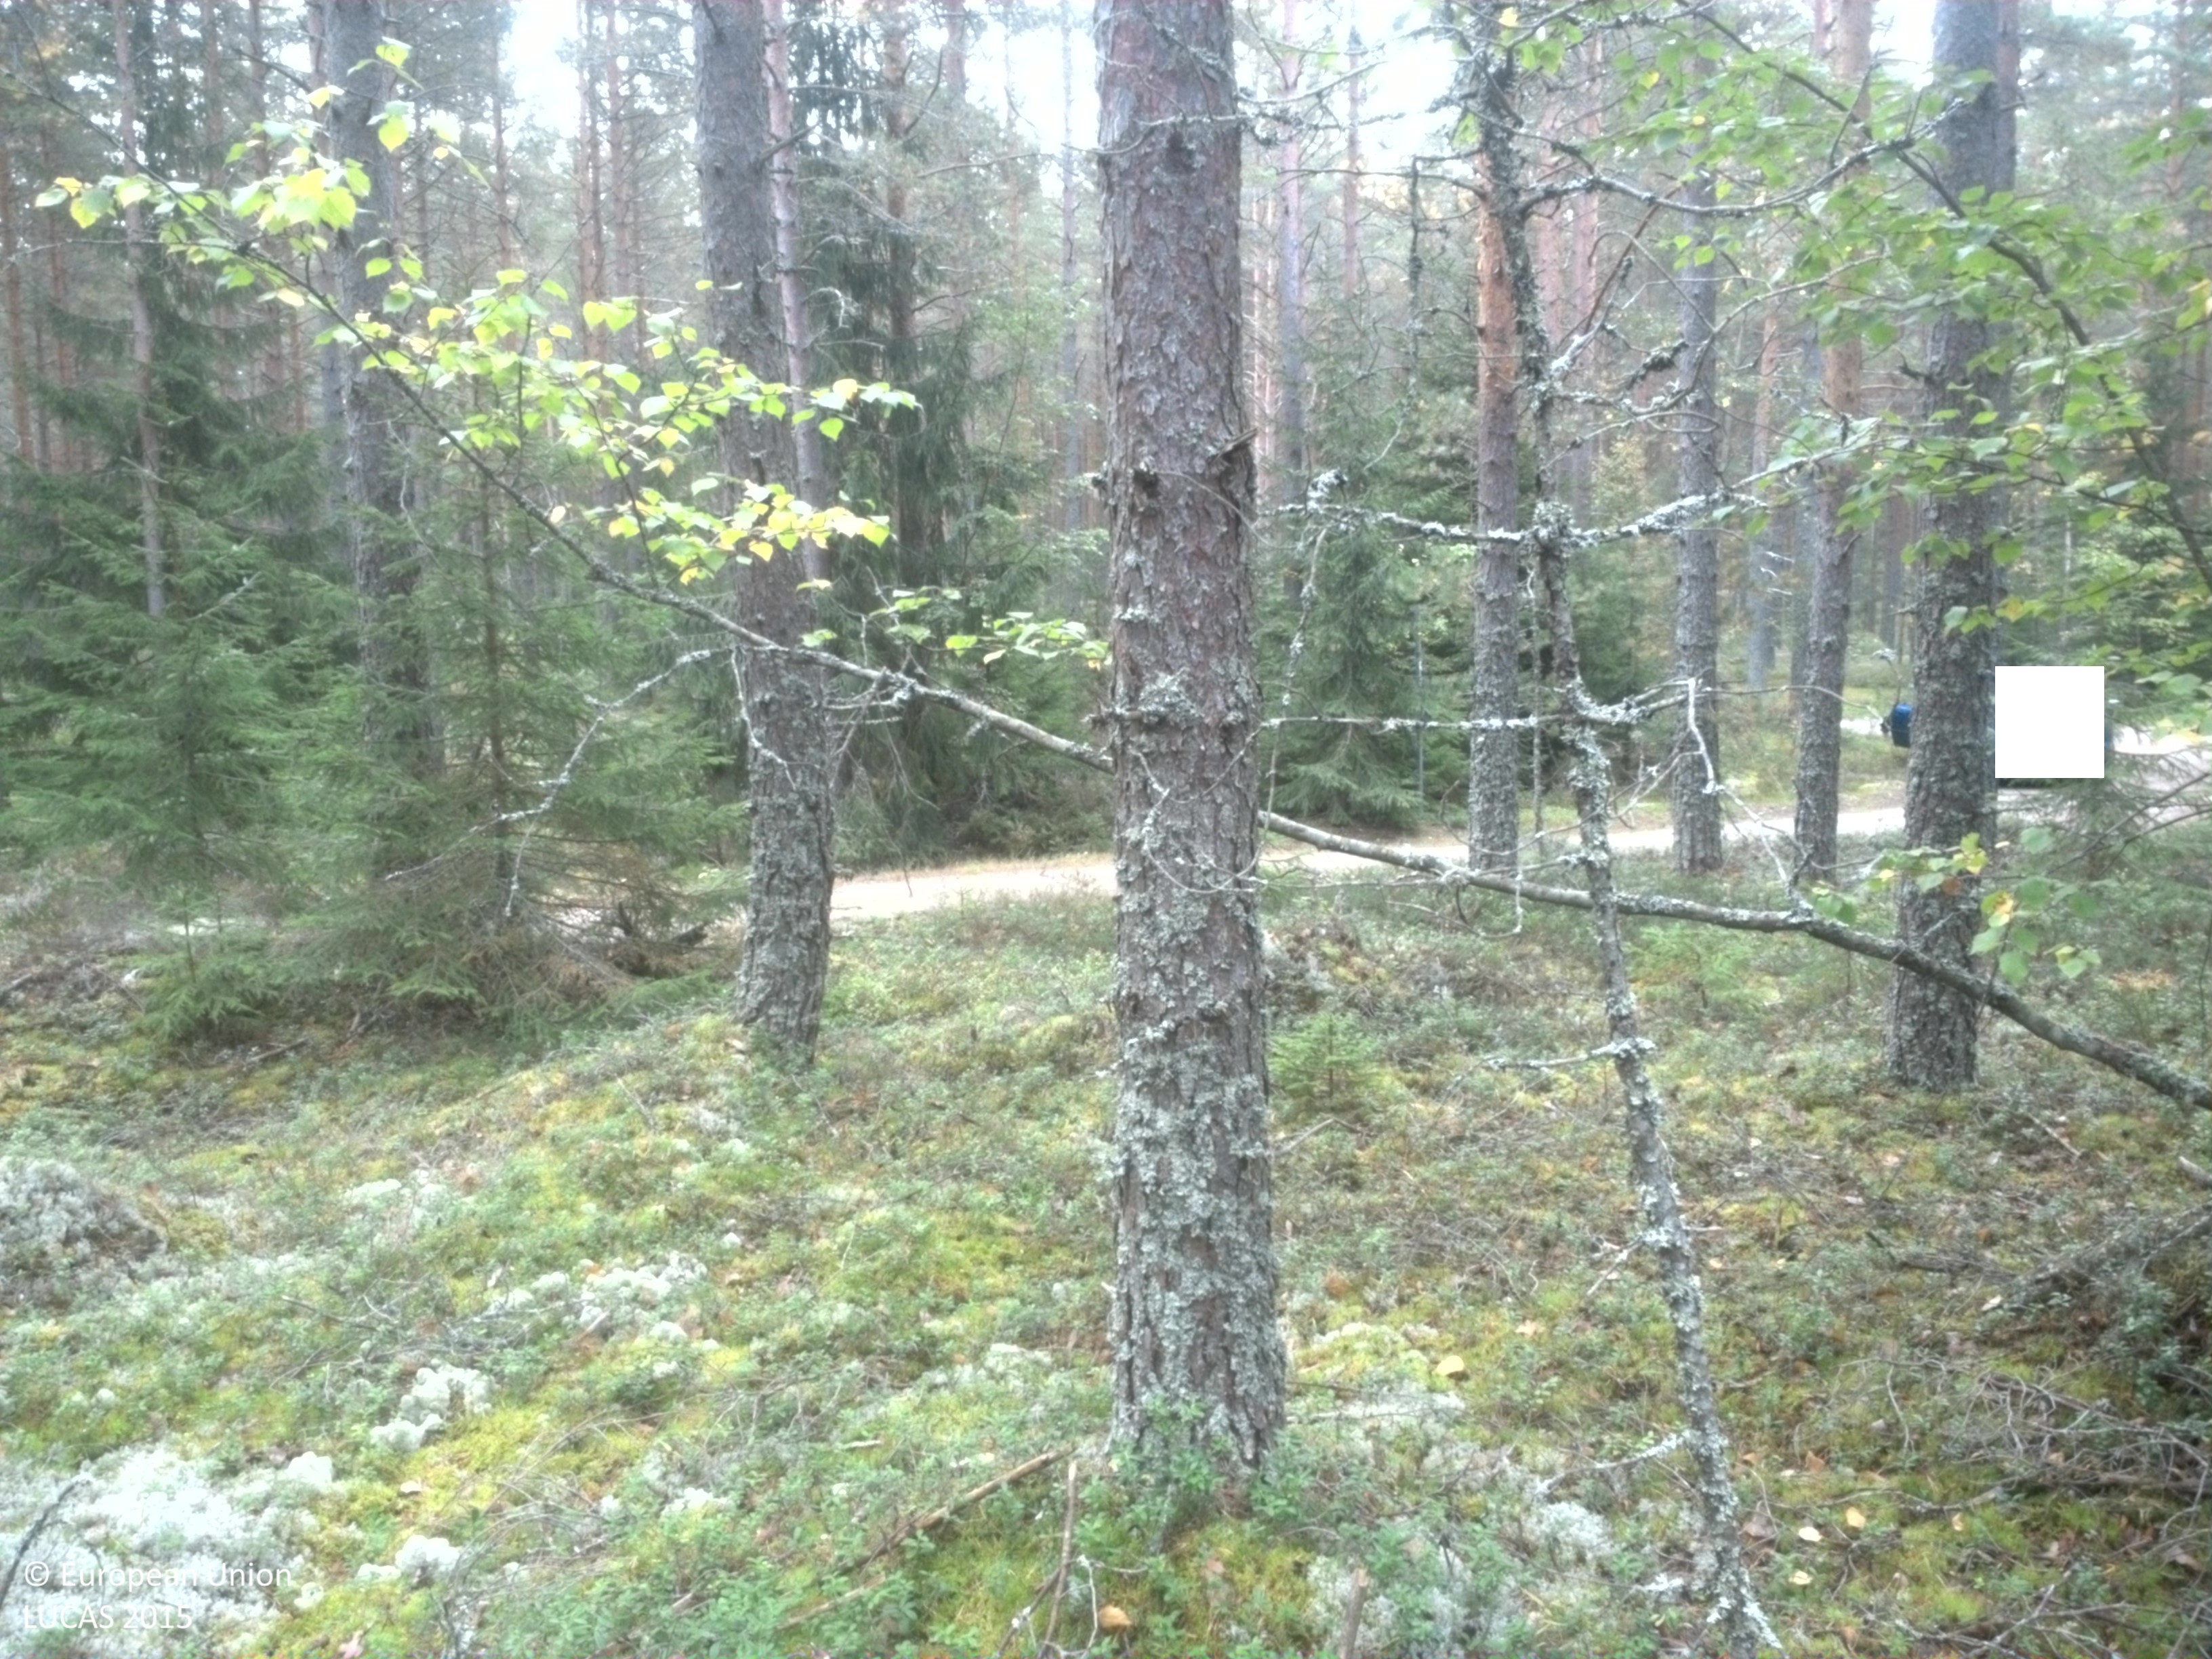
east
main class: Woodland
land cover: Pine dominated coniferous woodland
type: boreal forest
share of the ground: 50 - 75 %
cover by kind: coniferous forest trees 70 %, lichens and mosses 20 %, shrubs 10 %
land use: Forestry
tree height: > 5 m
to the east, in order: Pine dominated coniferous woodland; Paved roads, cycling and walking lanes; Pine dominated coniferous woodland; Paved roads, cycling and walking lanes; Pine dominated coniferous woodland; Grassland with sparse tree/shrub cover
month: September
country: SE
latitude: 59.8028
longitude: 15.4978
